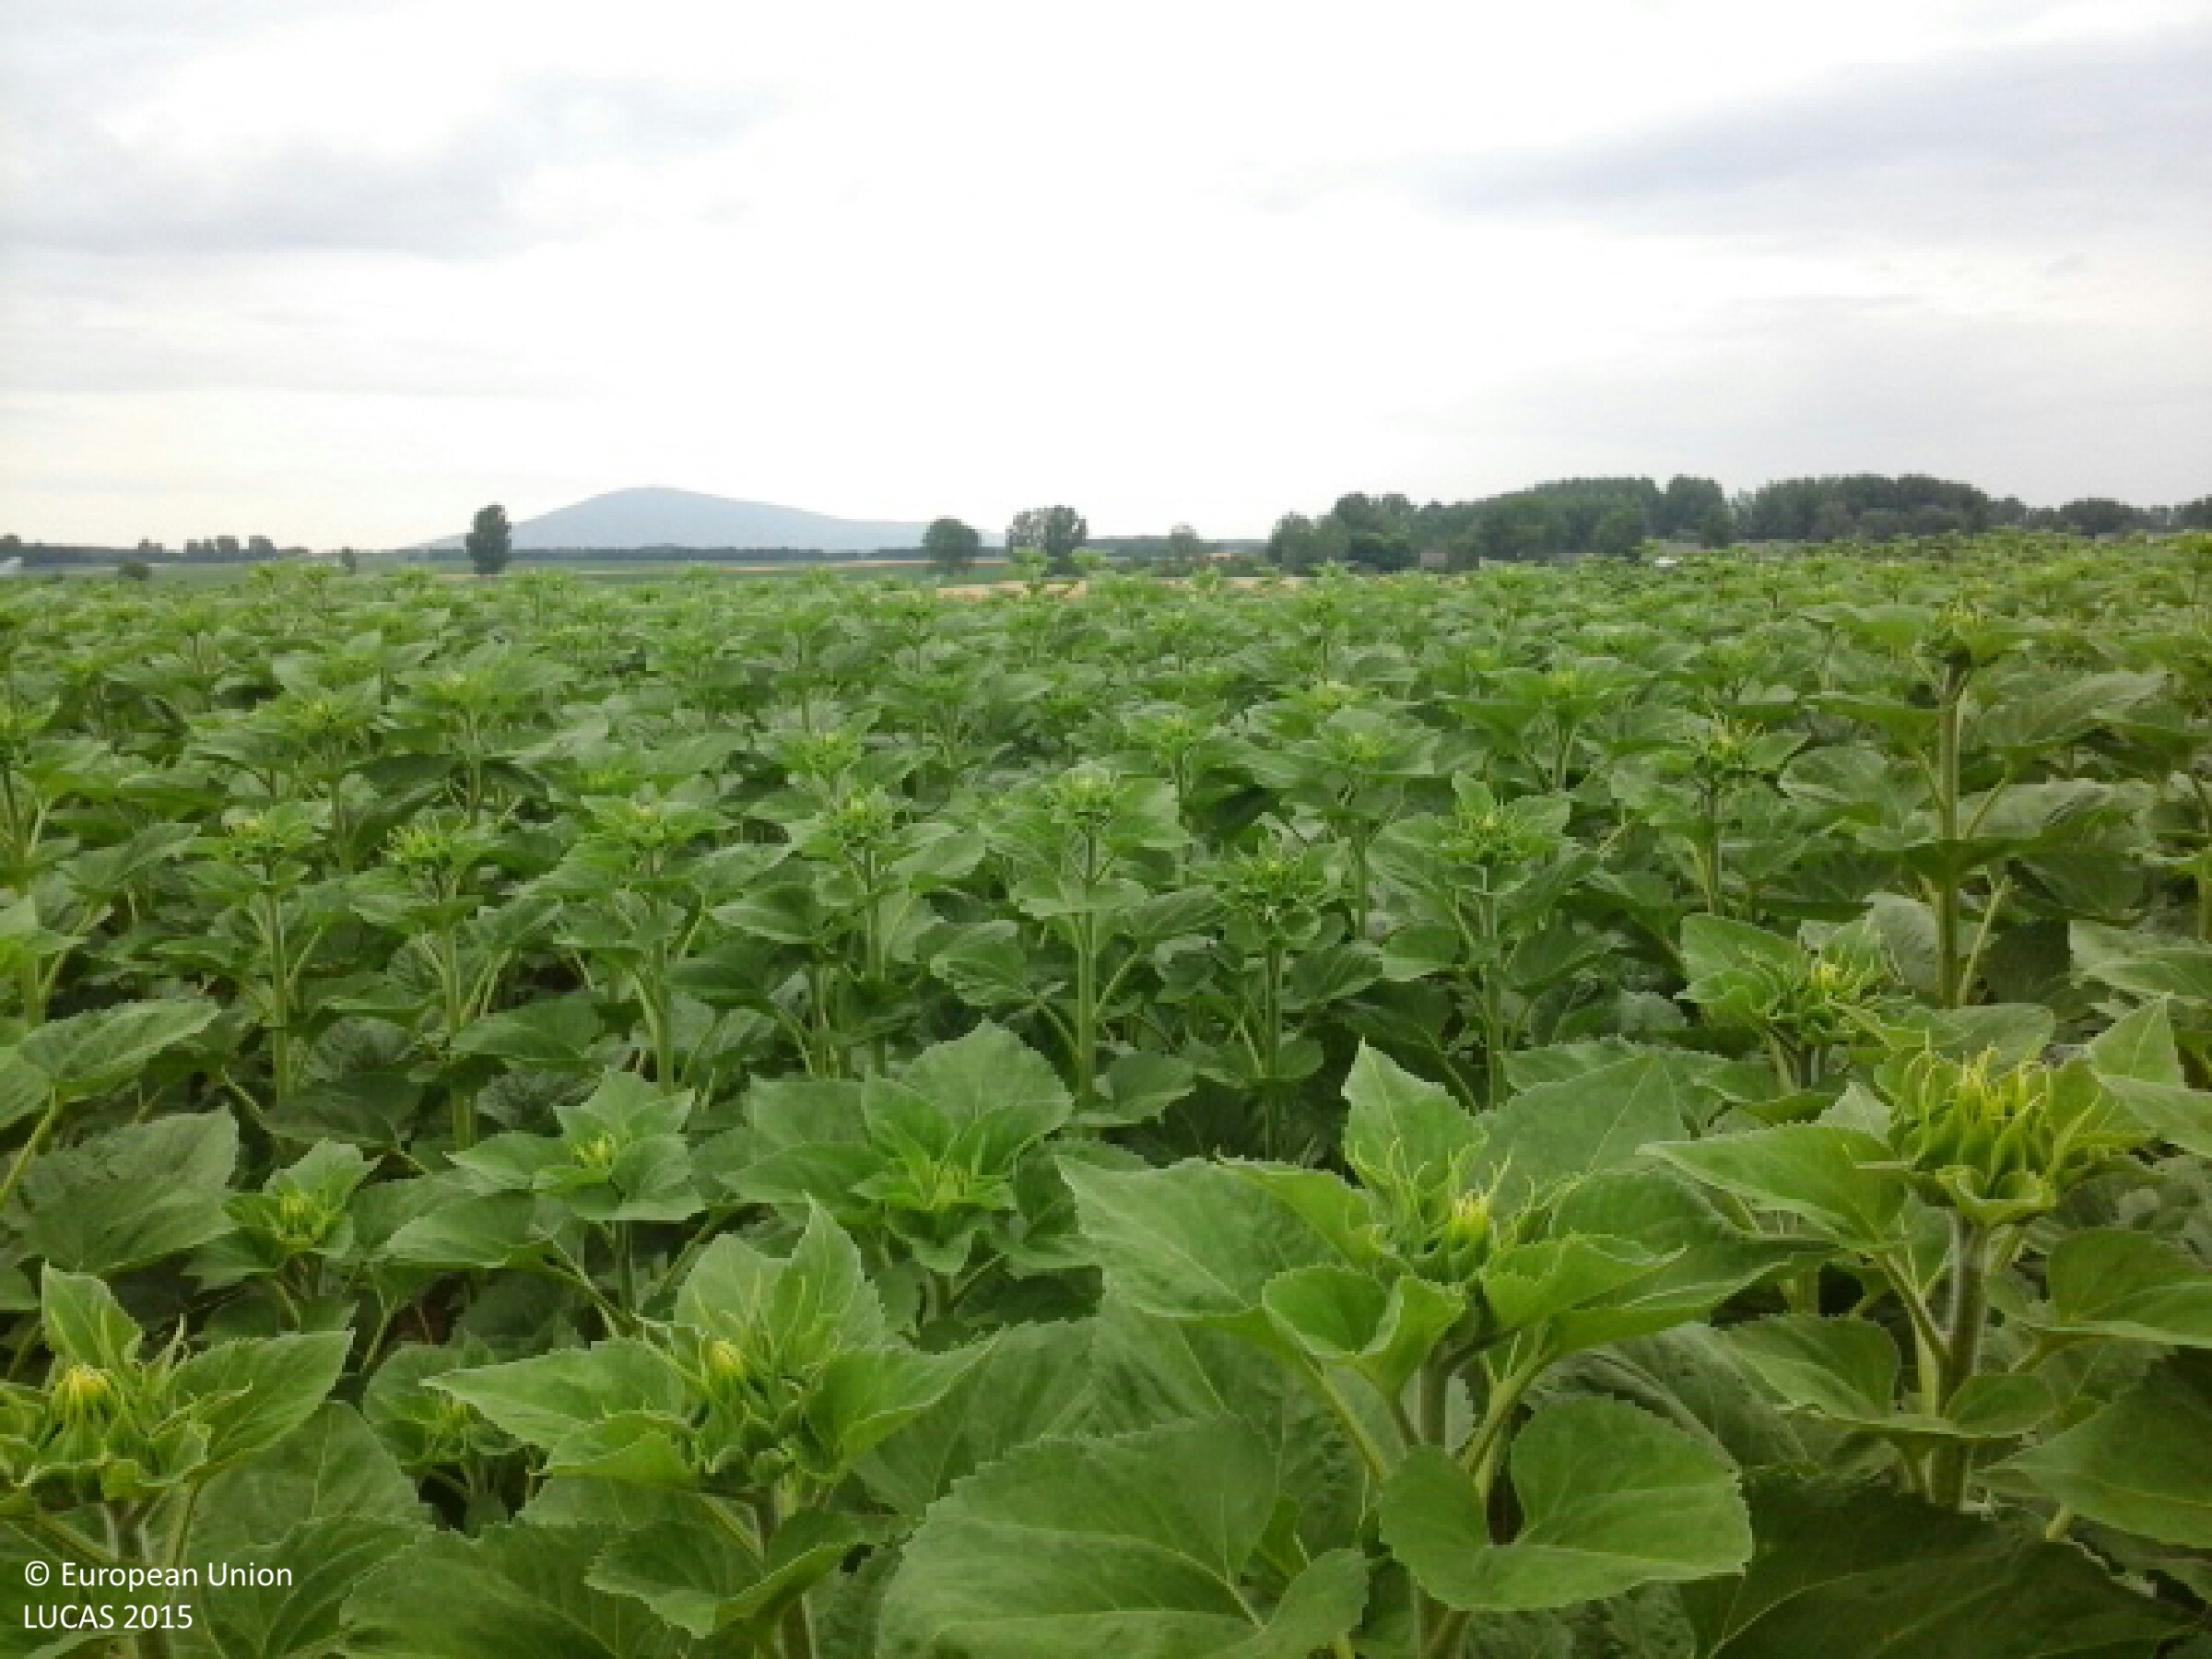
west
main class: Cropland
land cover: Sunflower
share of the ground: > 75 %
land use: Agriculture (excluding fallow land and kitchen gardens)
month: June
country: HU
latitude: 48.1604
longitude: 21.5411
